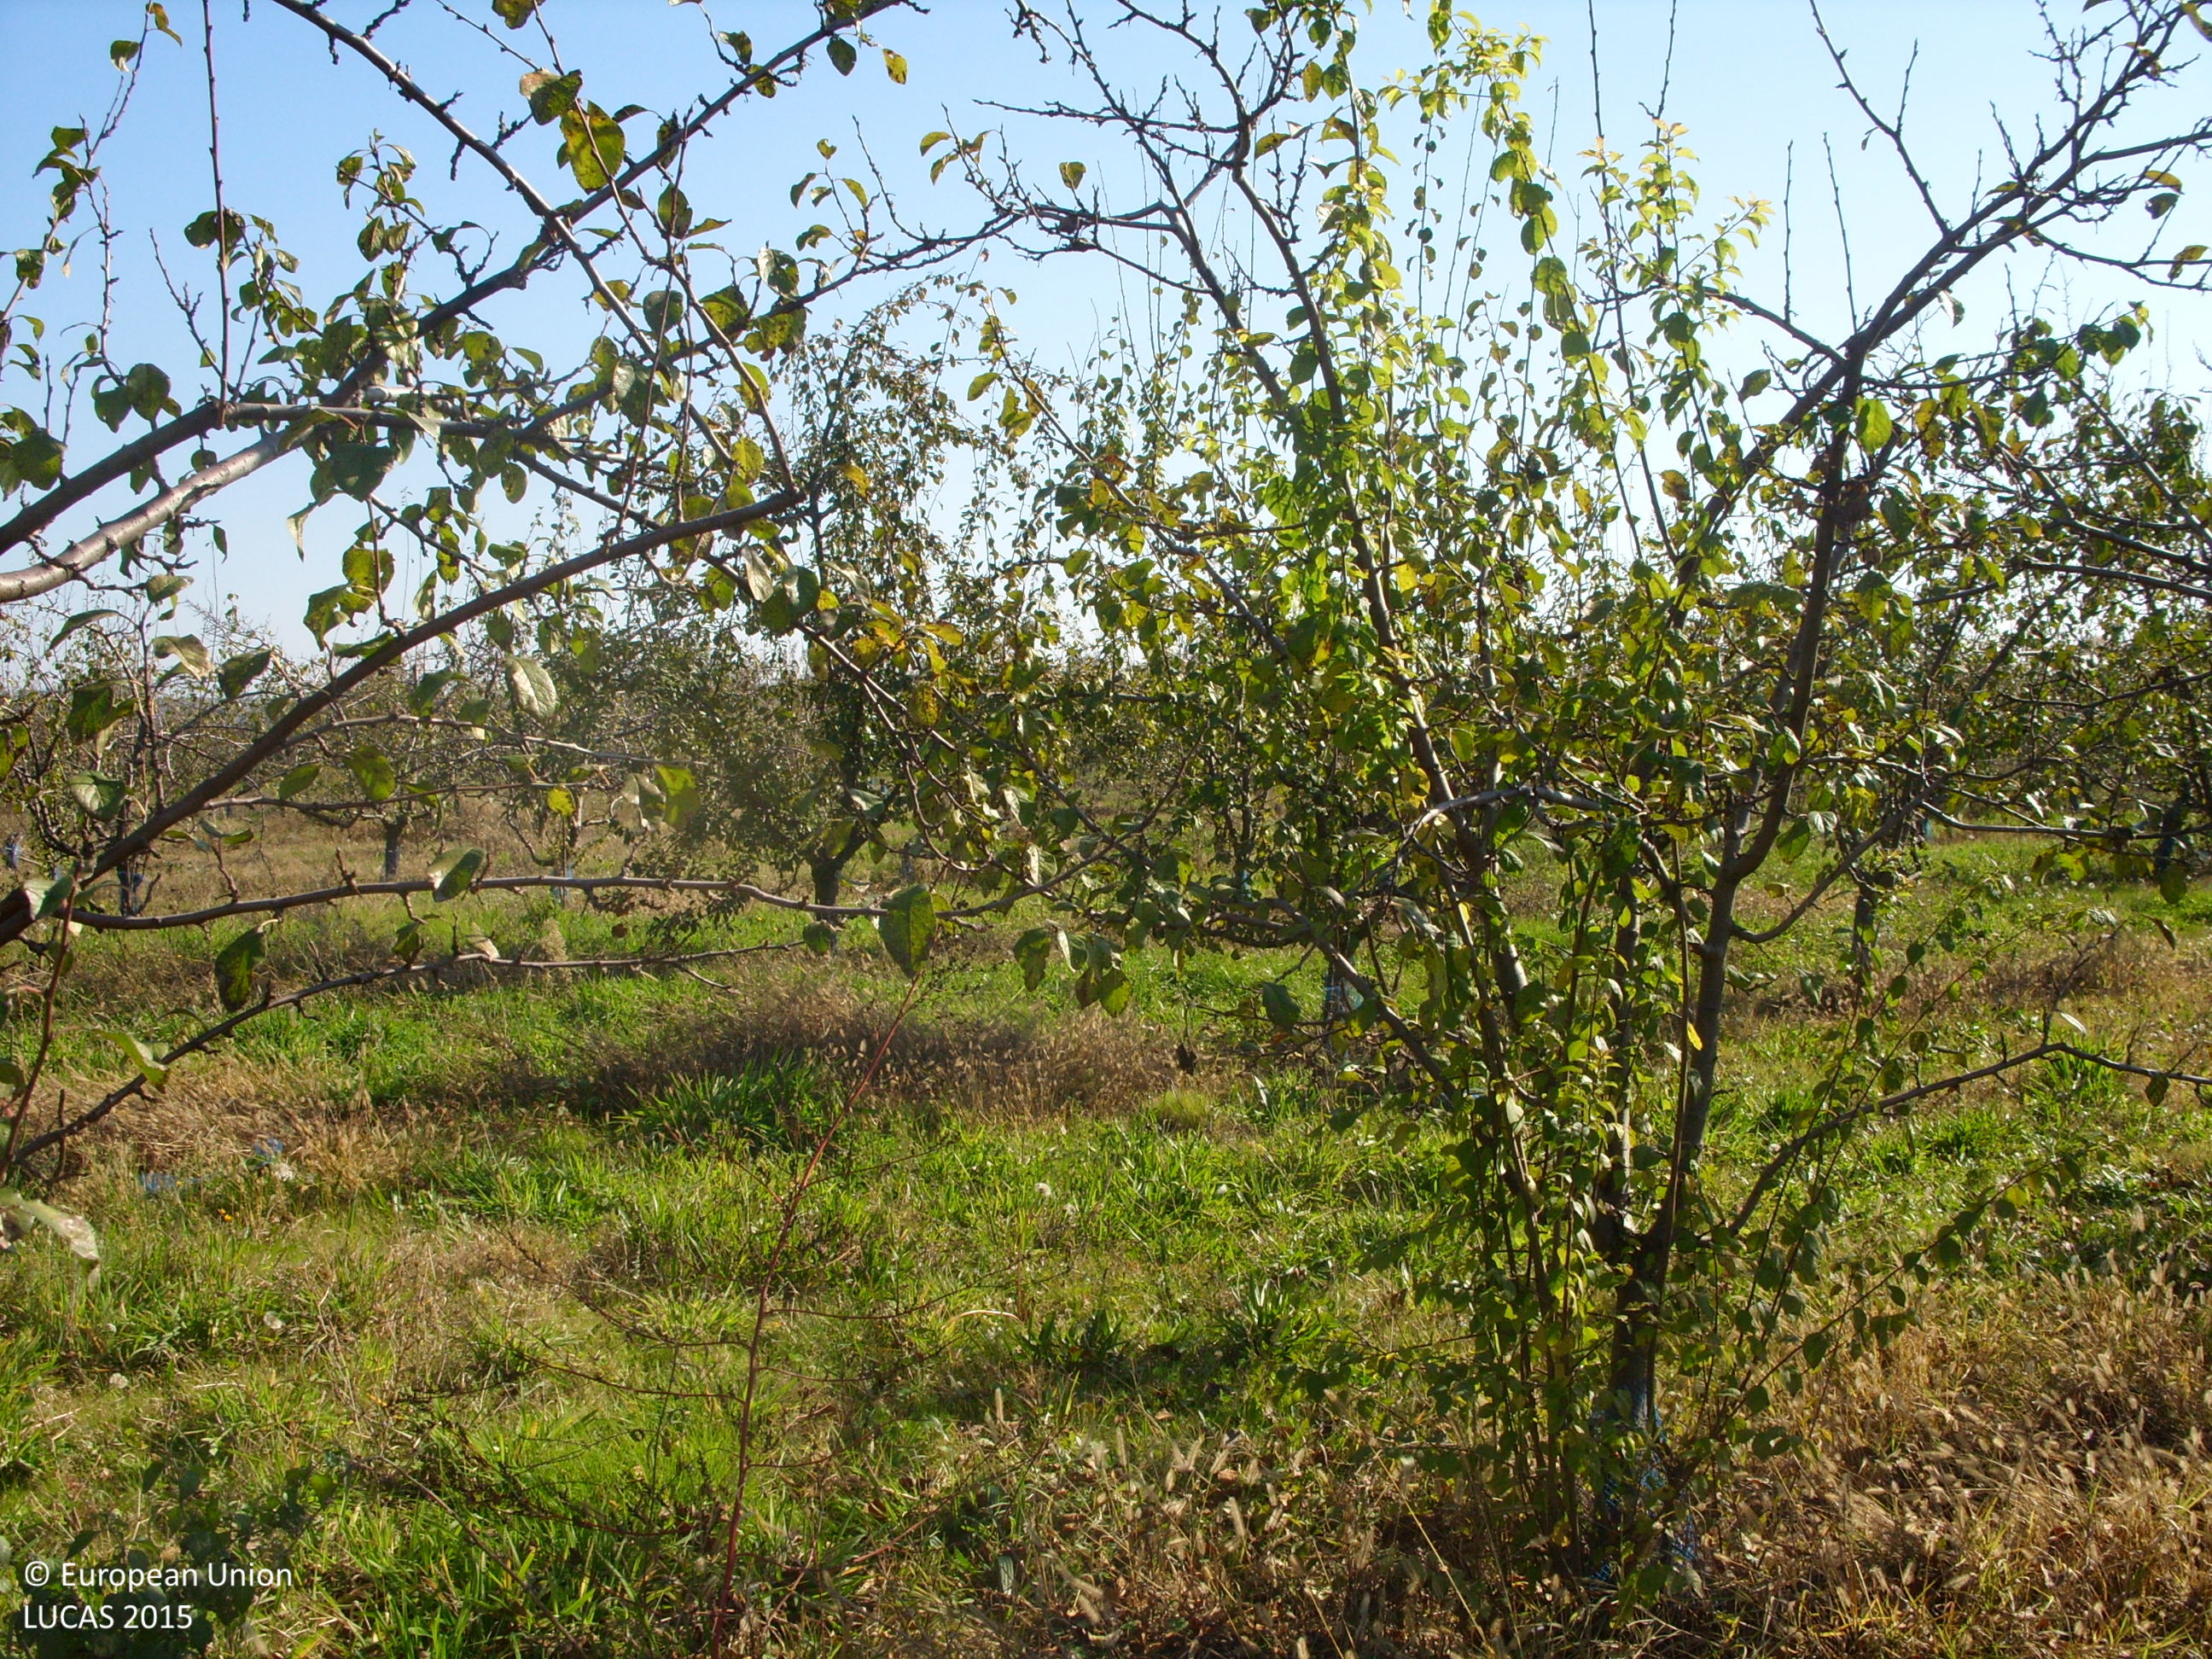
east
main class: Cropland
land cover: Other fruit trees and berries
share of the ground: 10 - 25 %
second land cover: Spontaneously vegetated surfaces
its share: > 75 %
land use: Agriculture (excluding fallow land and kitchen gardens)
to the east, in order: Other fruit trees and berries; Spontaneously vegetated surfaces; Tracks; Grassland with sparse tree/shrub cover; Ditches and canals; Grassland with sparse tree/shrub cover; Tracks; Grass margins; Fences; Vineyards
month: November
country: BG
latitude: 42.4569
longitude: 24.6825
